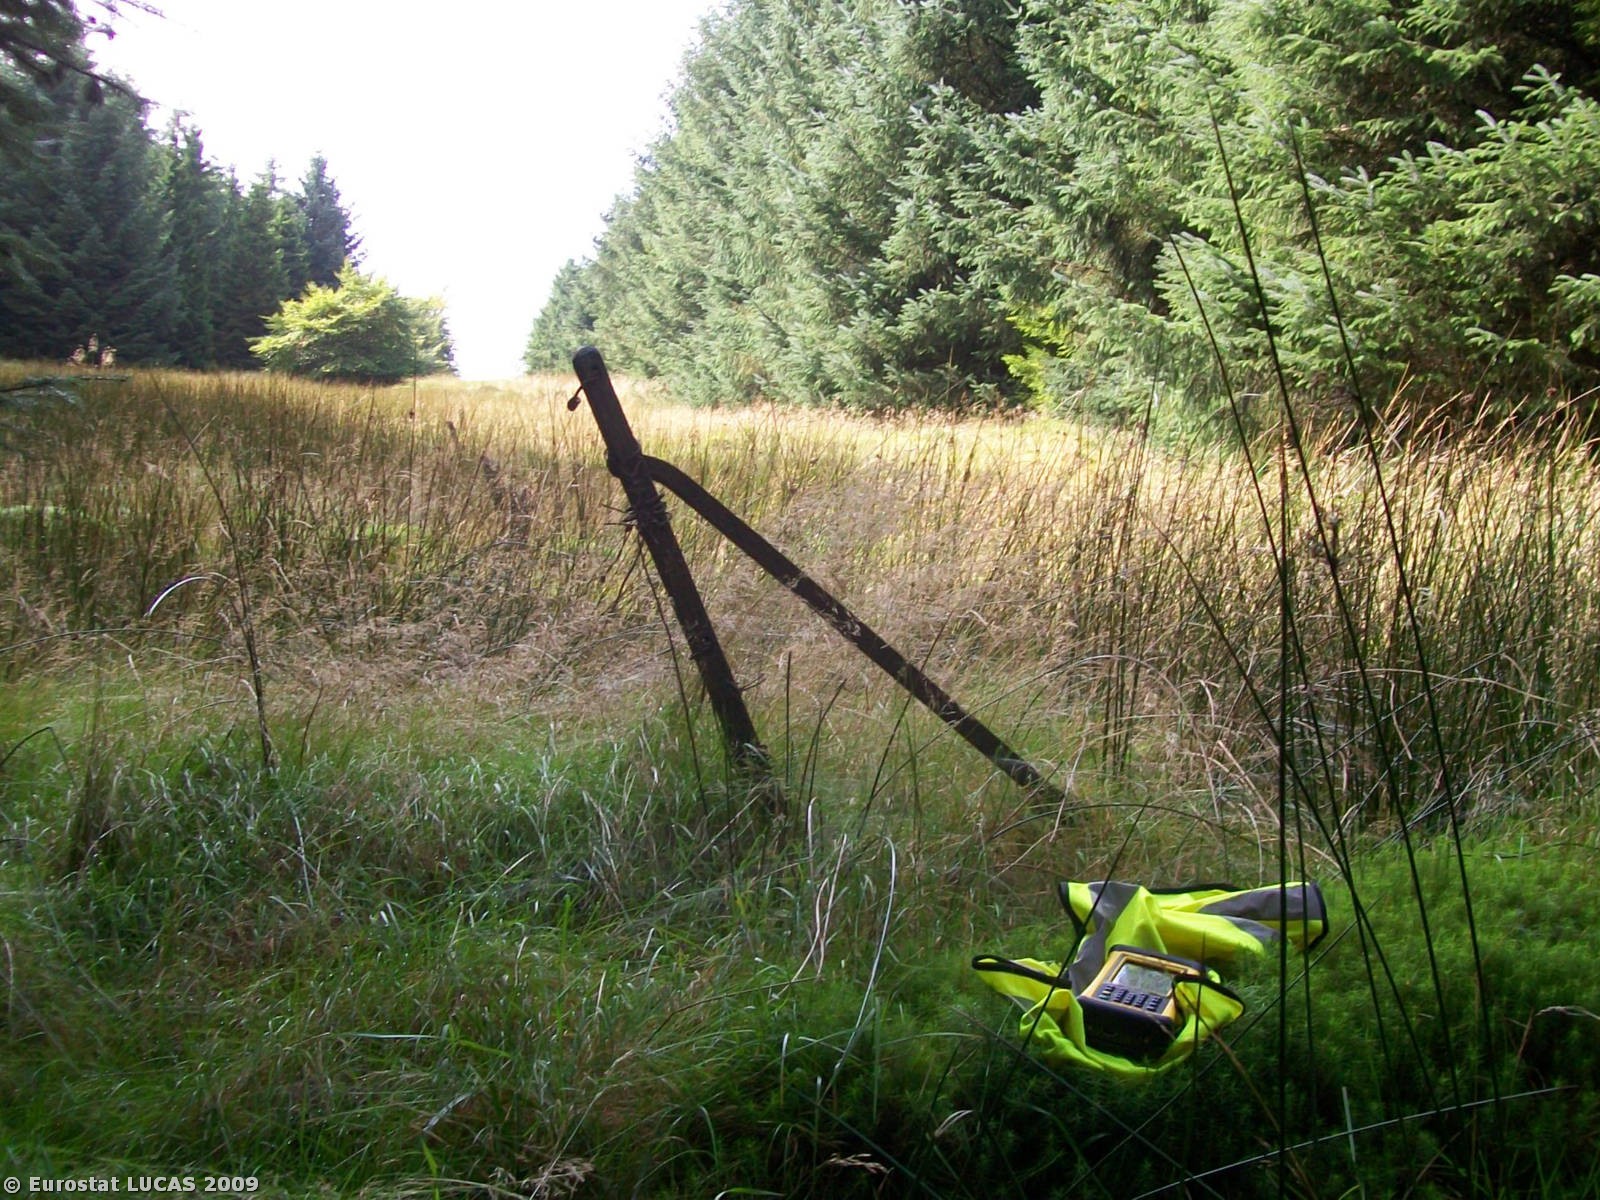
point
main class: Woodland
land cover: Coniferous woodland
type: plantations and self-sown exotic forest
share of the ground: > 75 %
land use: Forestry
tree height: > 5 m
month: September
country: GB
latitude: 55.5830
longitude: -4.2936
